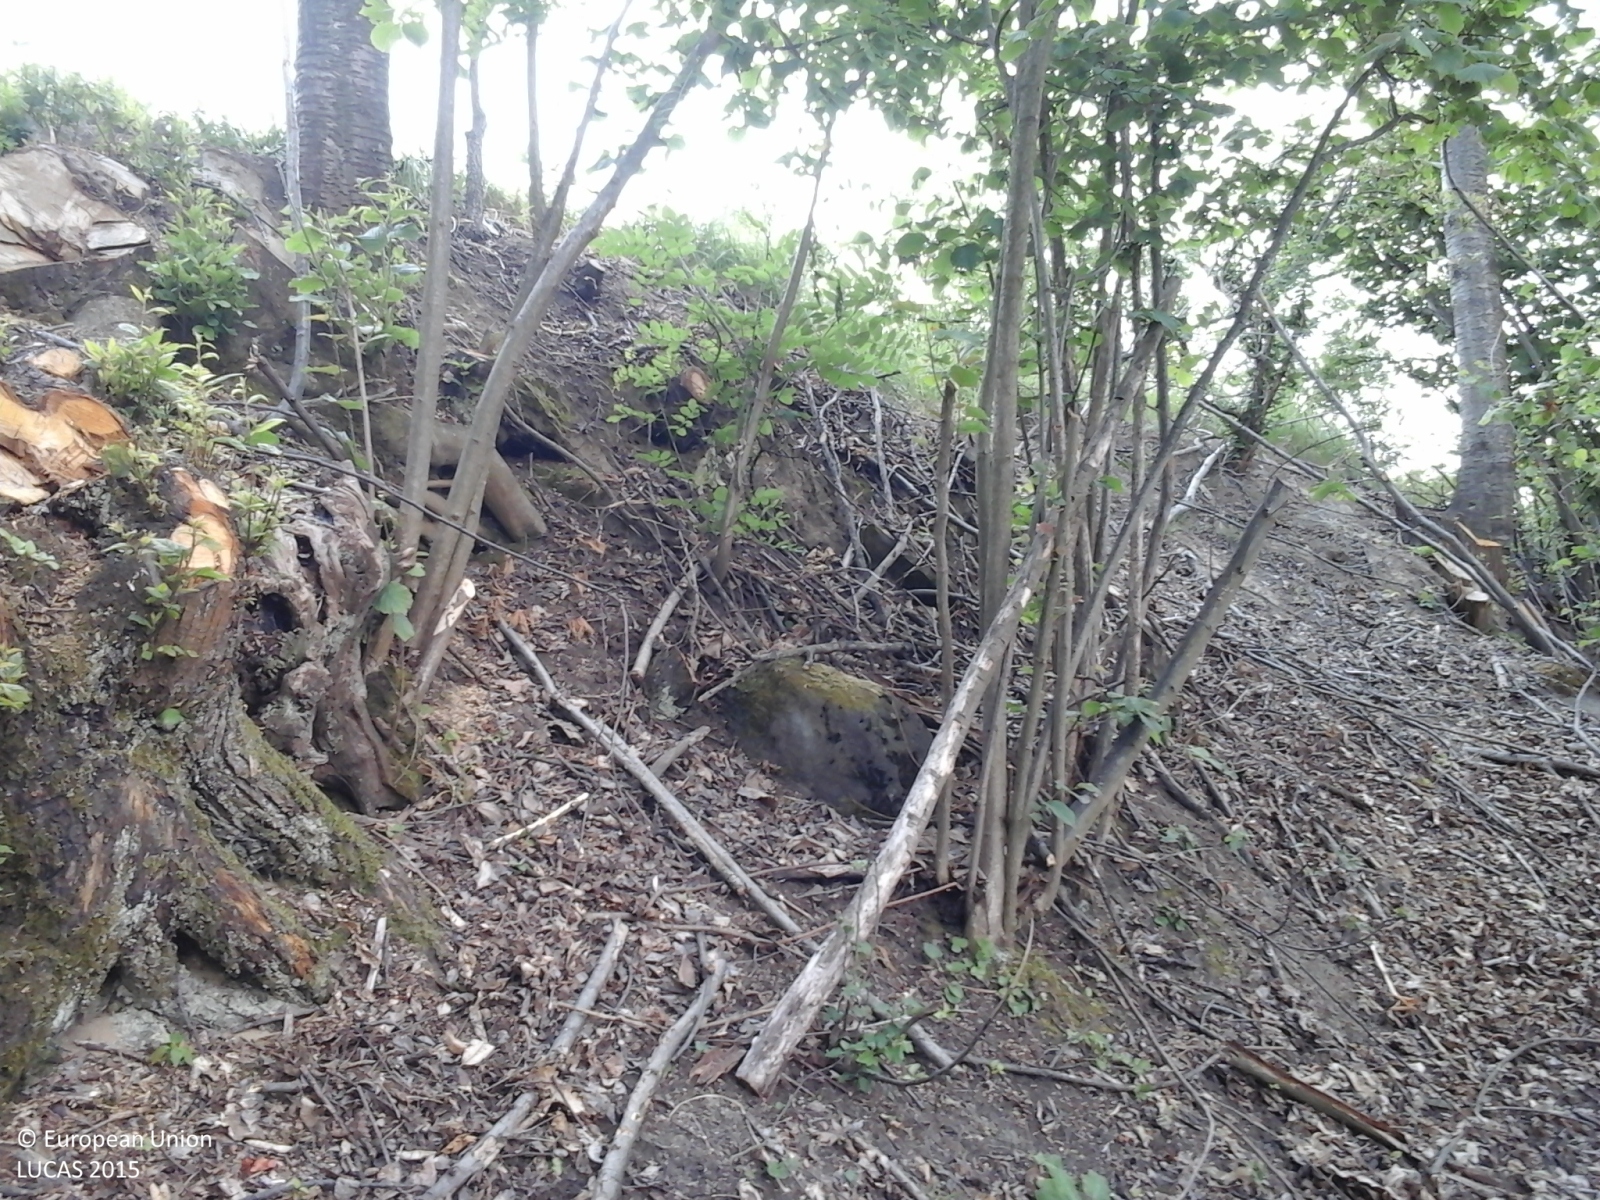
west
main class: Woodland
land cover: Broadleaved woodland
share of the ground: < 10 %
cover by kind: herbaceous plants 30 %, consolidated bare surface 30 %, broadleaved forest trees 20 %, shrubs 20 %
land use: Forestry
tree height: < 5 m
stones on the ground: 25 - 50 %
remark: Clear cut
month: June
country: IT
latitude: 44.5735
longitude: 8.4544
